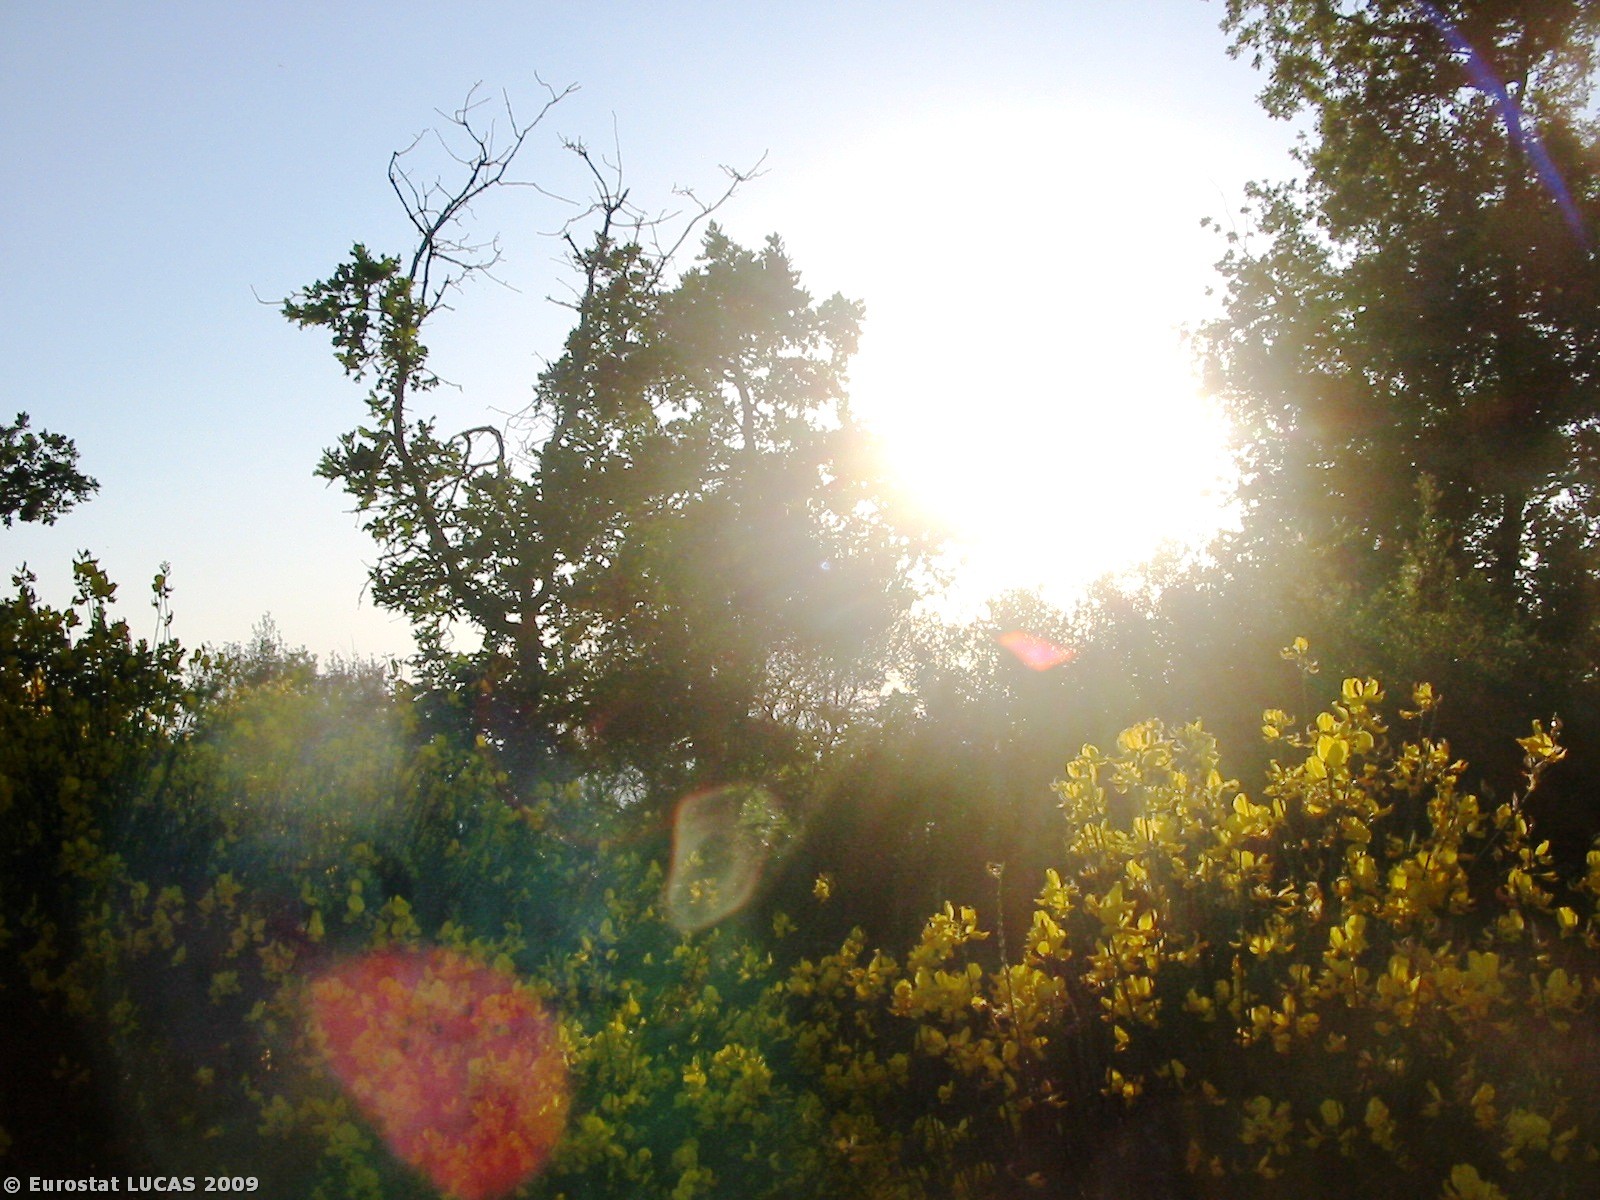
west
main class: Shrubland
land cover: Shrubland with sparse tree cover
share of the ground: > 75 %
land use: Unused
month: June
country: IT
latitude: 43.2844
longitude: 12.0031
